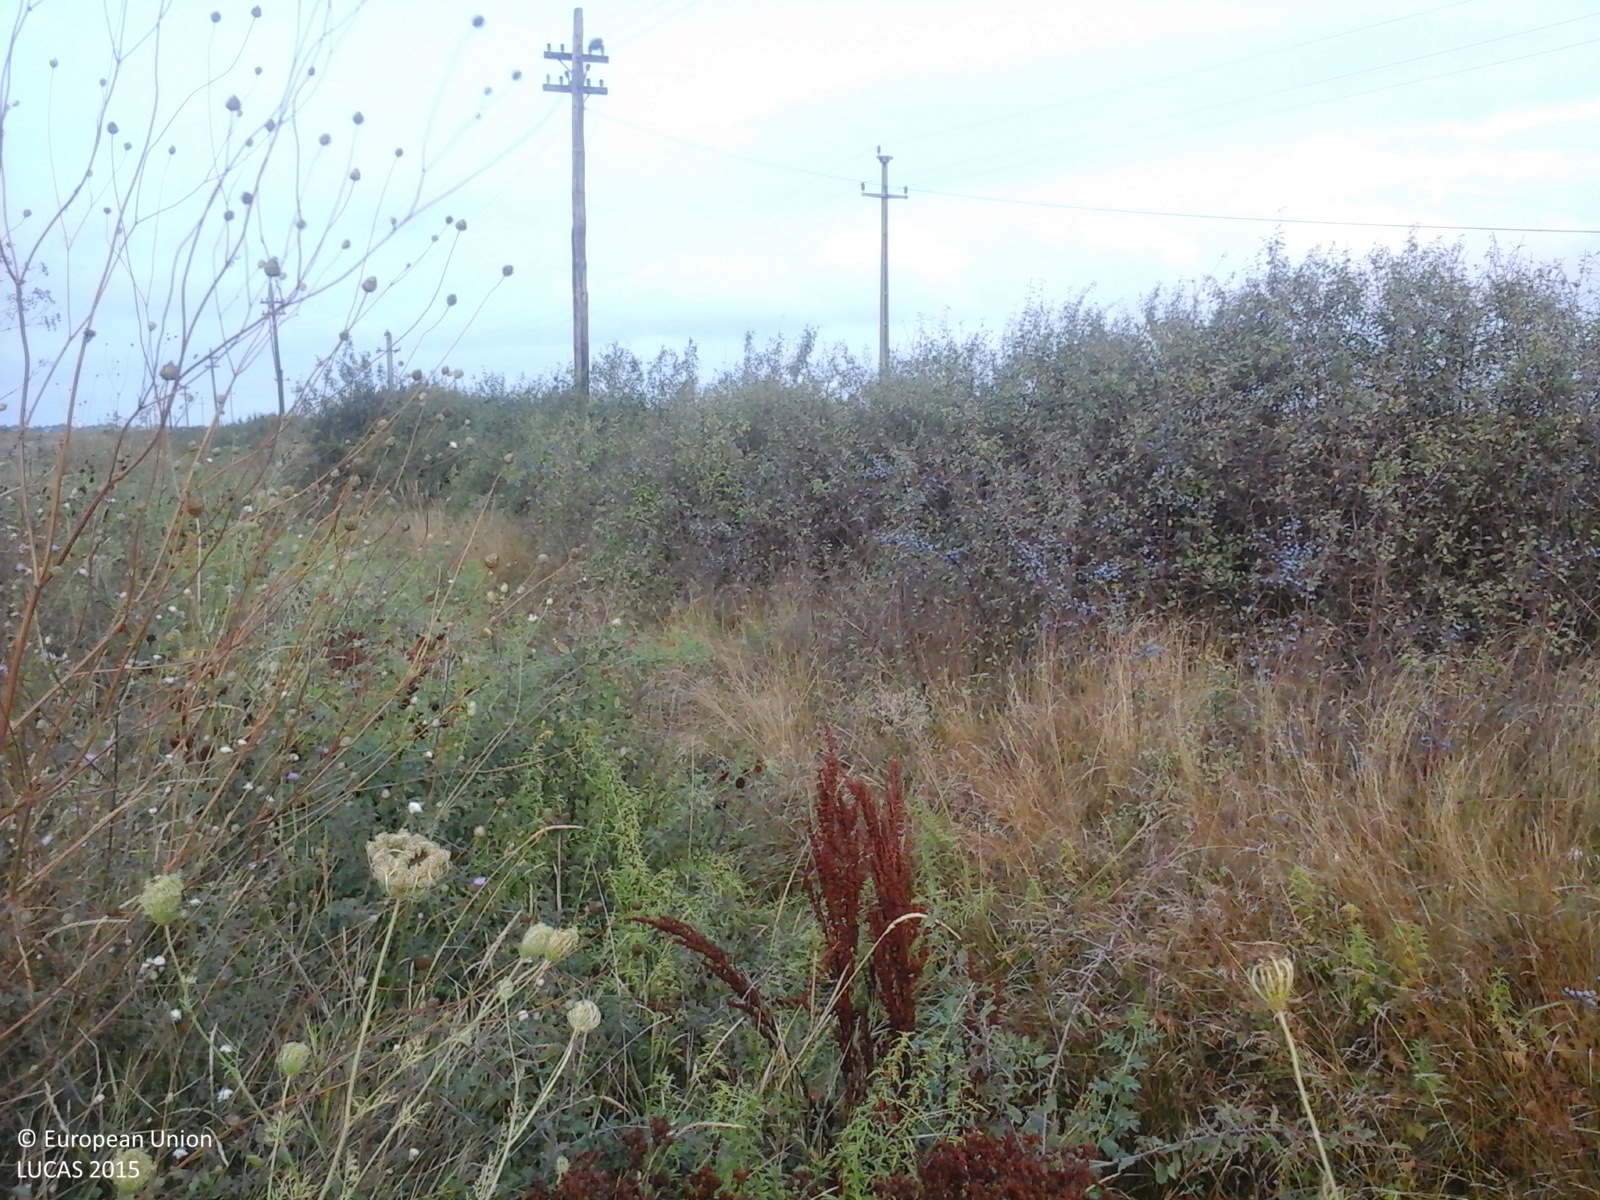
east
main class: Cropland
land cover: Sunflower
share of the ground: > 75 %
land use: Agriculture (excluding fallow land and kitchen gardens)
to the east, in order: Sunflower
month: August
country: RO
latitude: 45.9916
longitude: 20.3640
